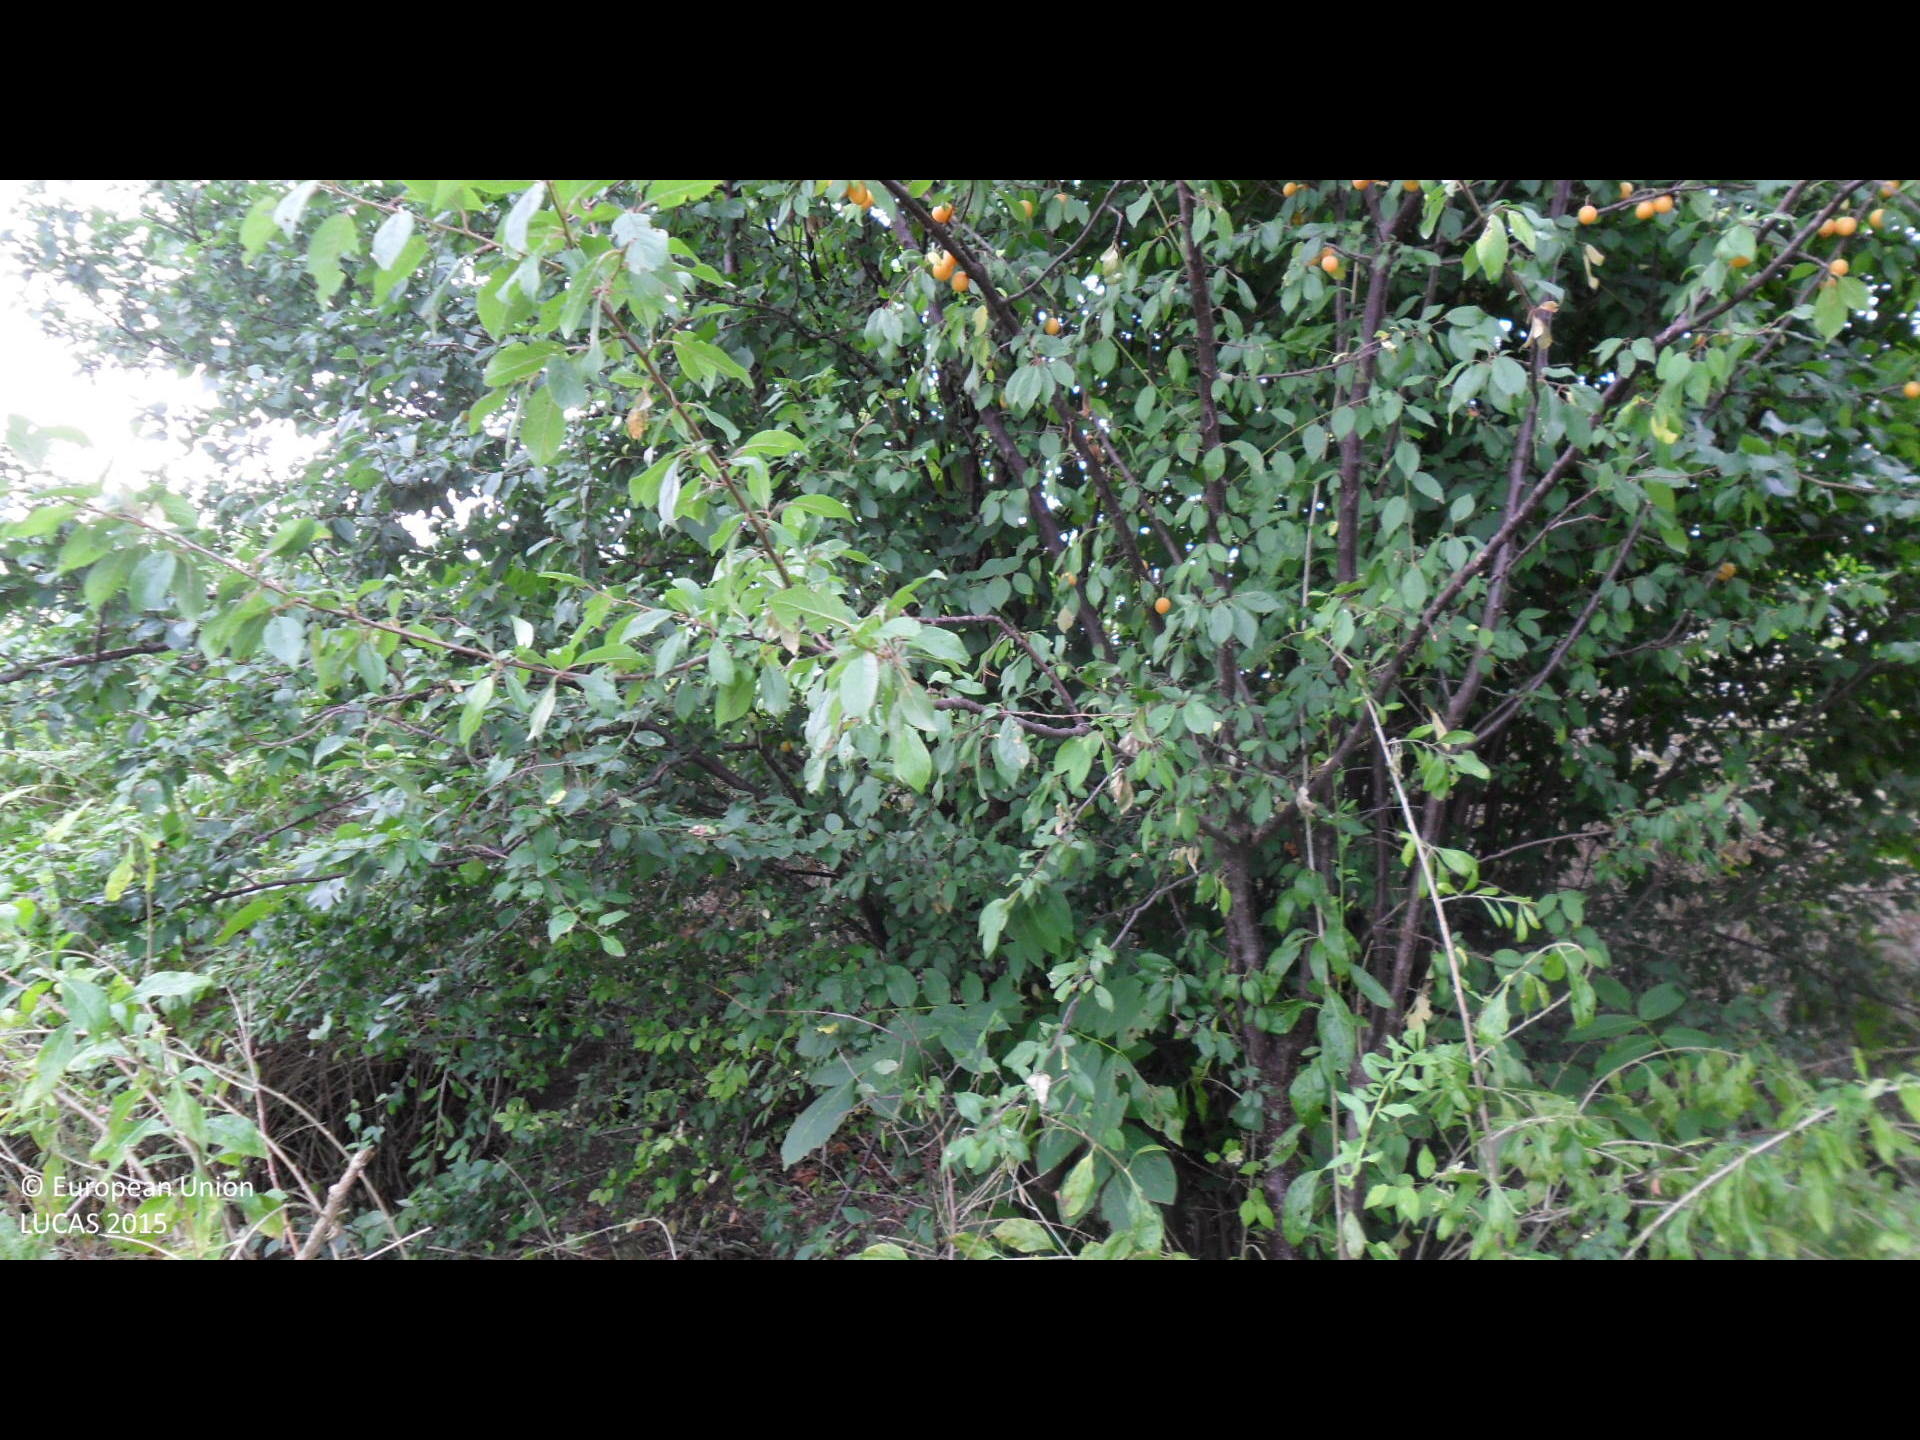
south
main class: Shrubland
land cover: Shrubland with sparse tree cover
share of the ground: > 75 %
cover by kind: shrubs 95 %, broadleaved forest trees 5 %
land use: Semi-natural and natural areas not in use
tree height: < 5 m
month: July
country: BG
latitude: 43.3537
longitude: 26.2469
